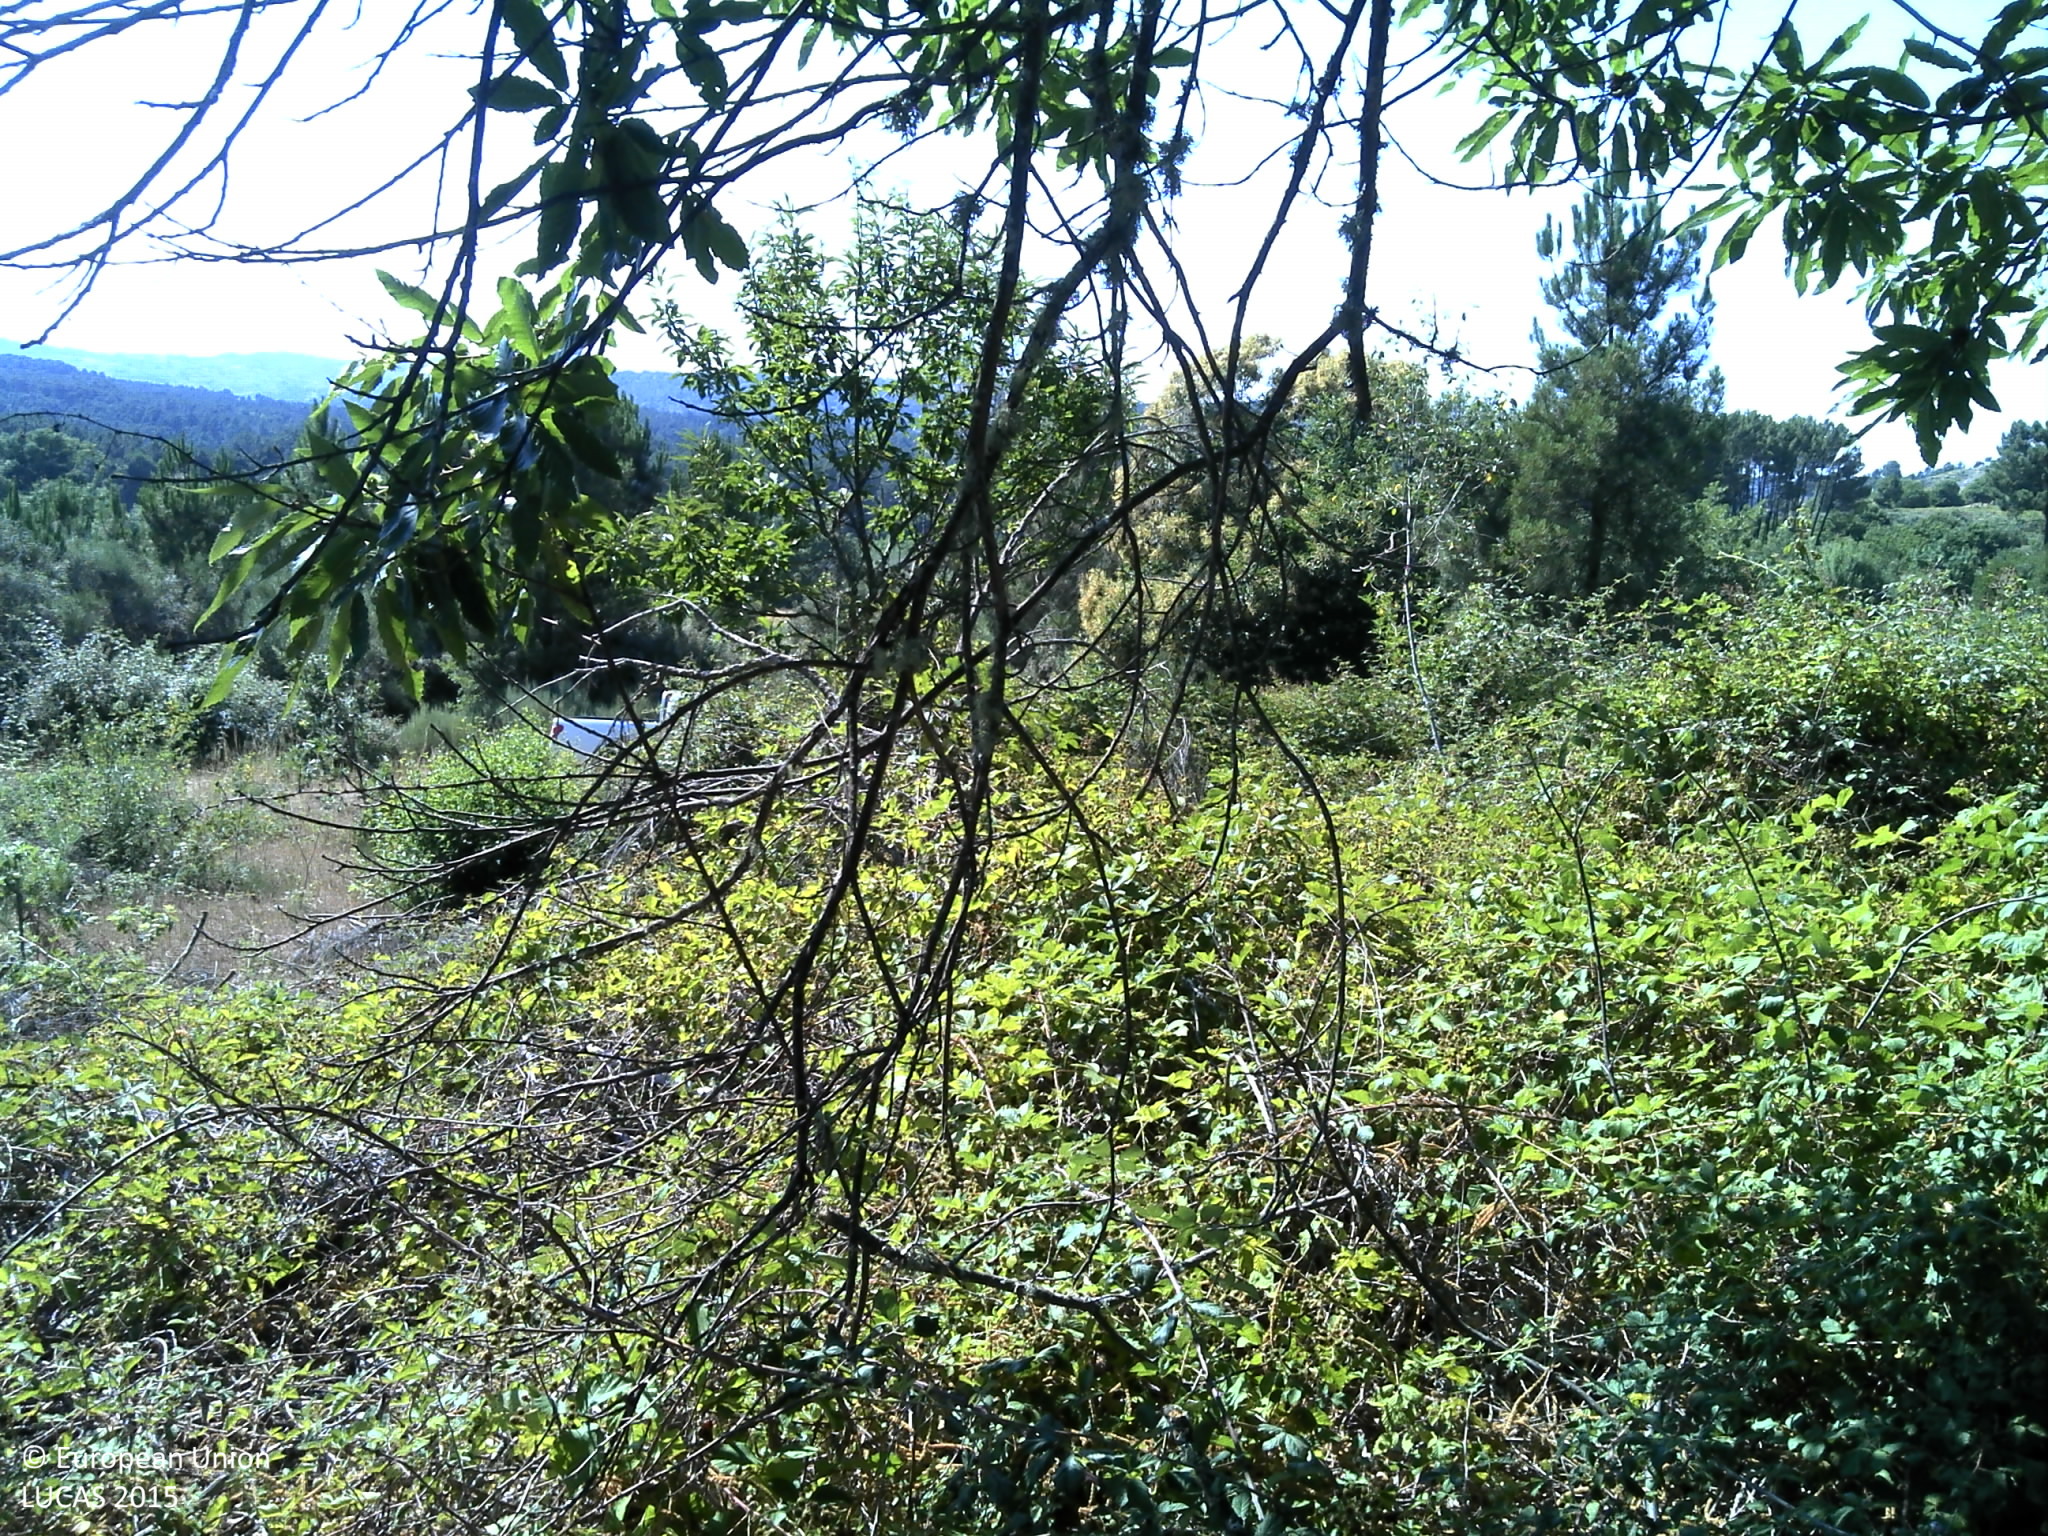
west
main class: Cropland
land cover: Nuts trees
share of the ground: < 10 %
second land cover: Shrubland without tree cover
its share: 25 - 50 %
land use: Agriculture (excluding fallow land and kitchen gardens)
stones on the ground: 25 - 50 %
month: July
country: PT
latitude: 40.8589
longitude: -7.4965
